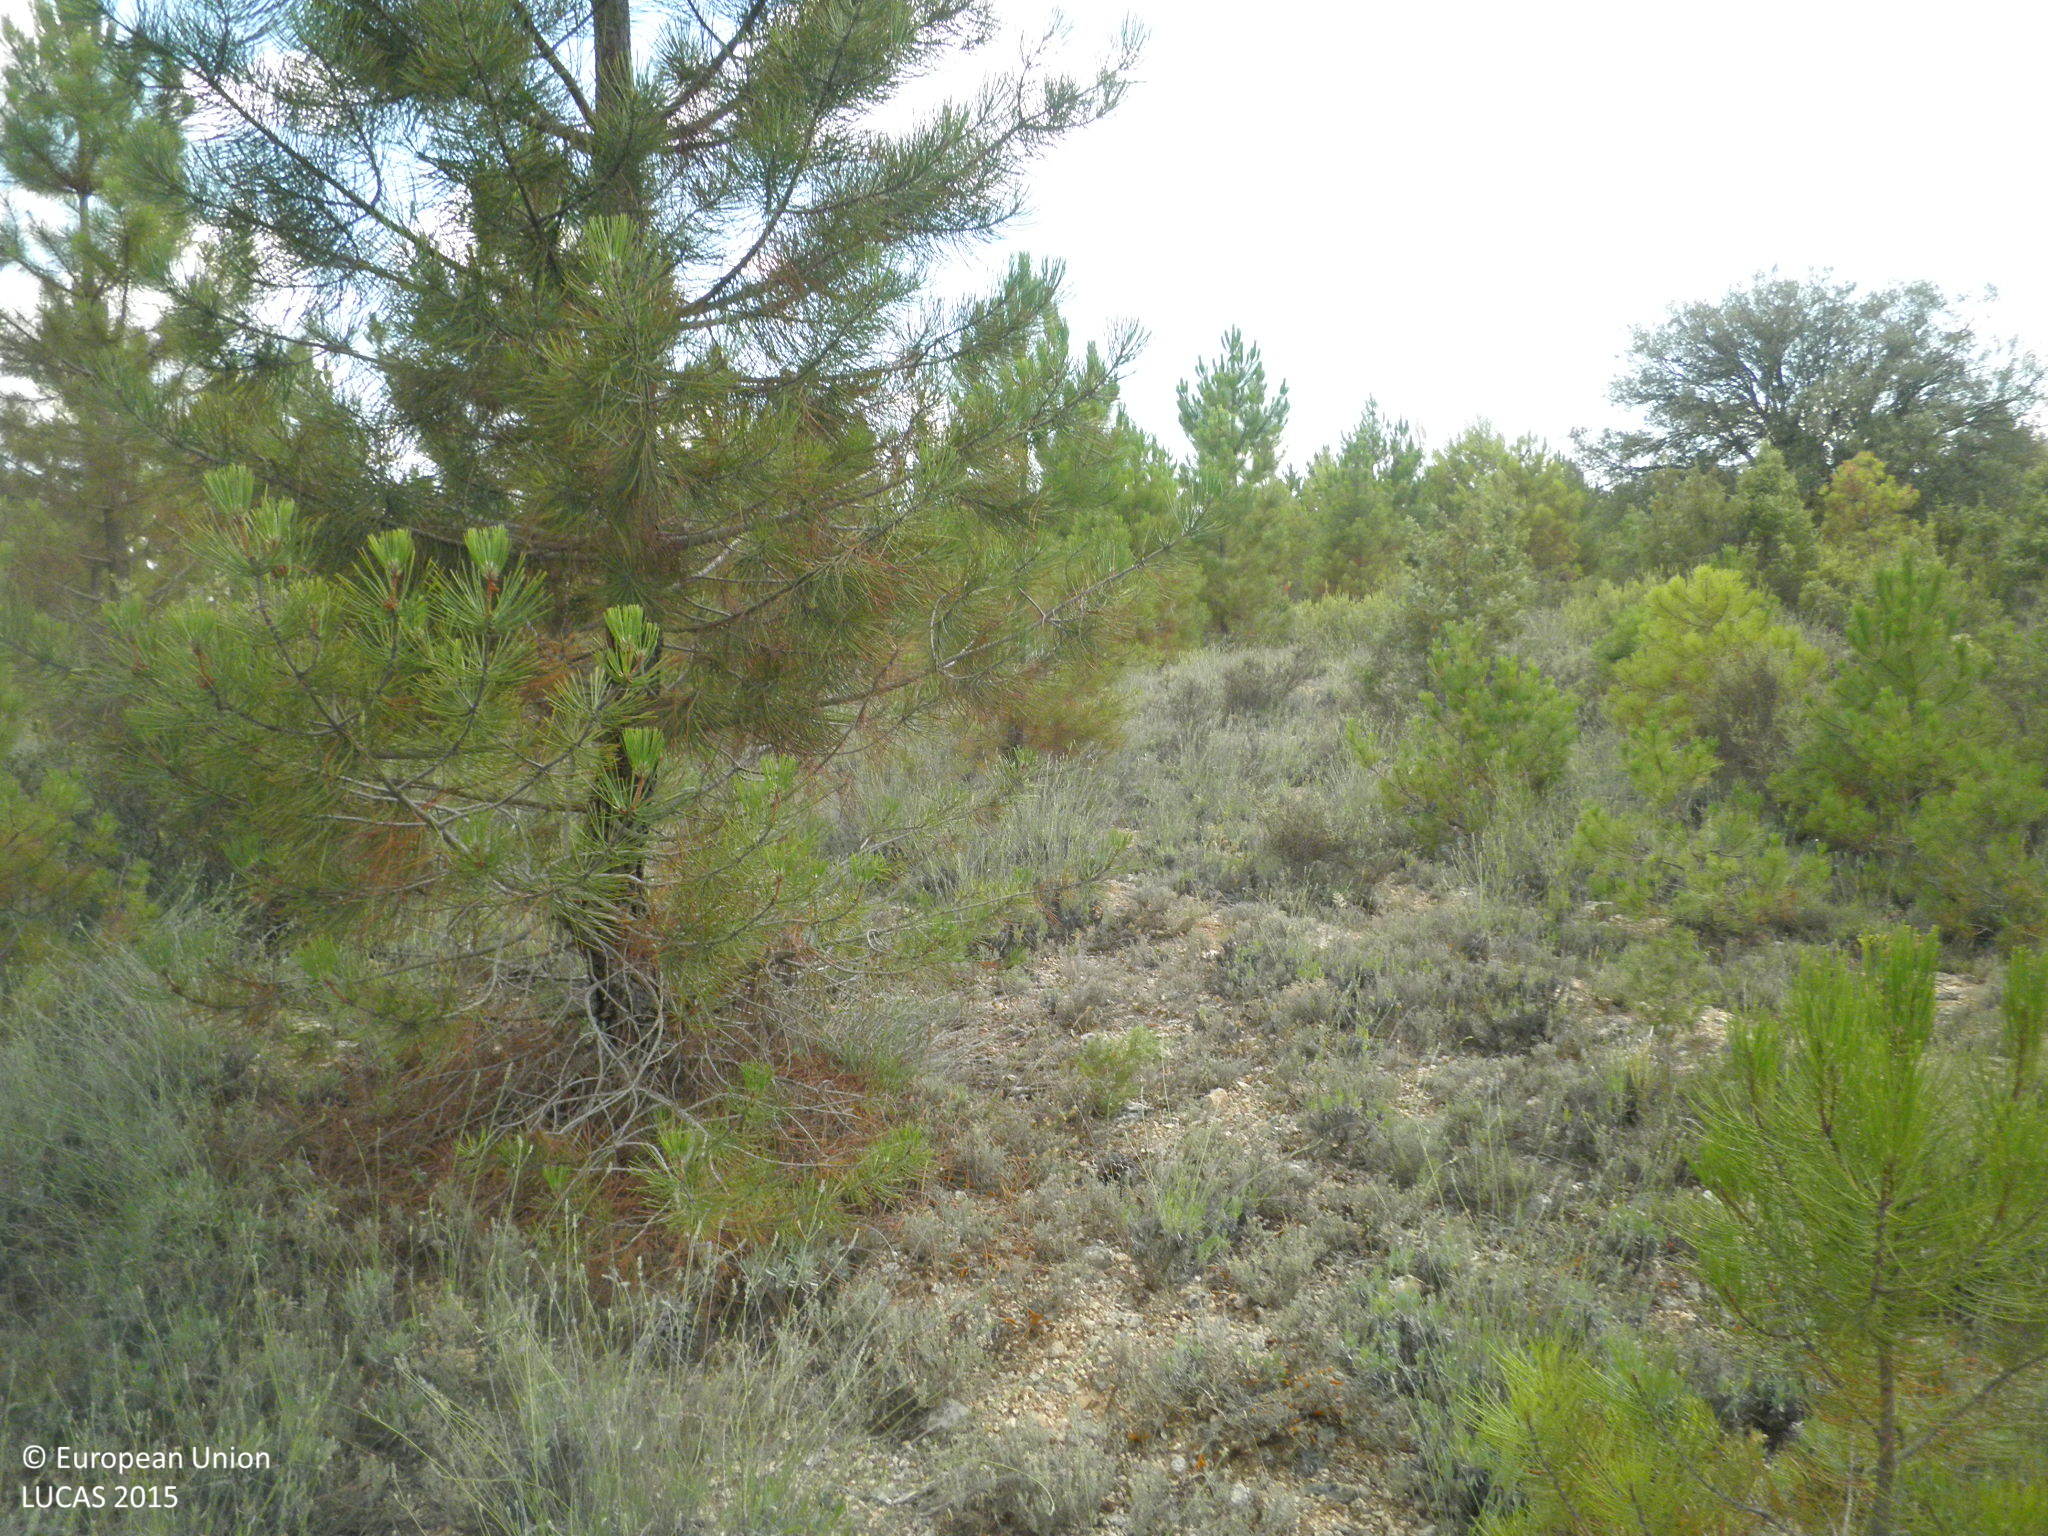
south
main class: Woodland
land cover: Pine dominated coniferous woodland
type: coniferous forest of the mediterranean region
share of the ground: 10 - 25 %
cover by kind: unconsolidated bare surface 40 %, coniferous forest trees 20 %, shrubs 20 %, herbaceous plants 20 %
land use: Semi-natural and natural areas not in use
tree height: < 5 m
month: July
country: ES
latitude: 39.7440
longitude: -1.8779
